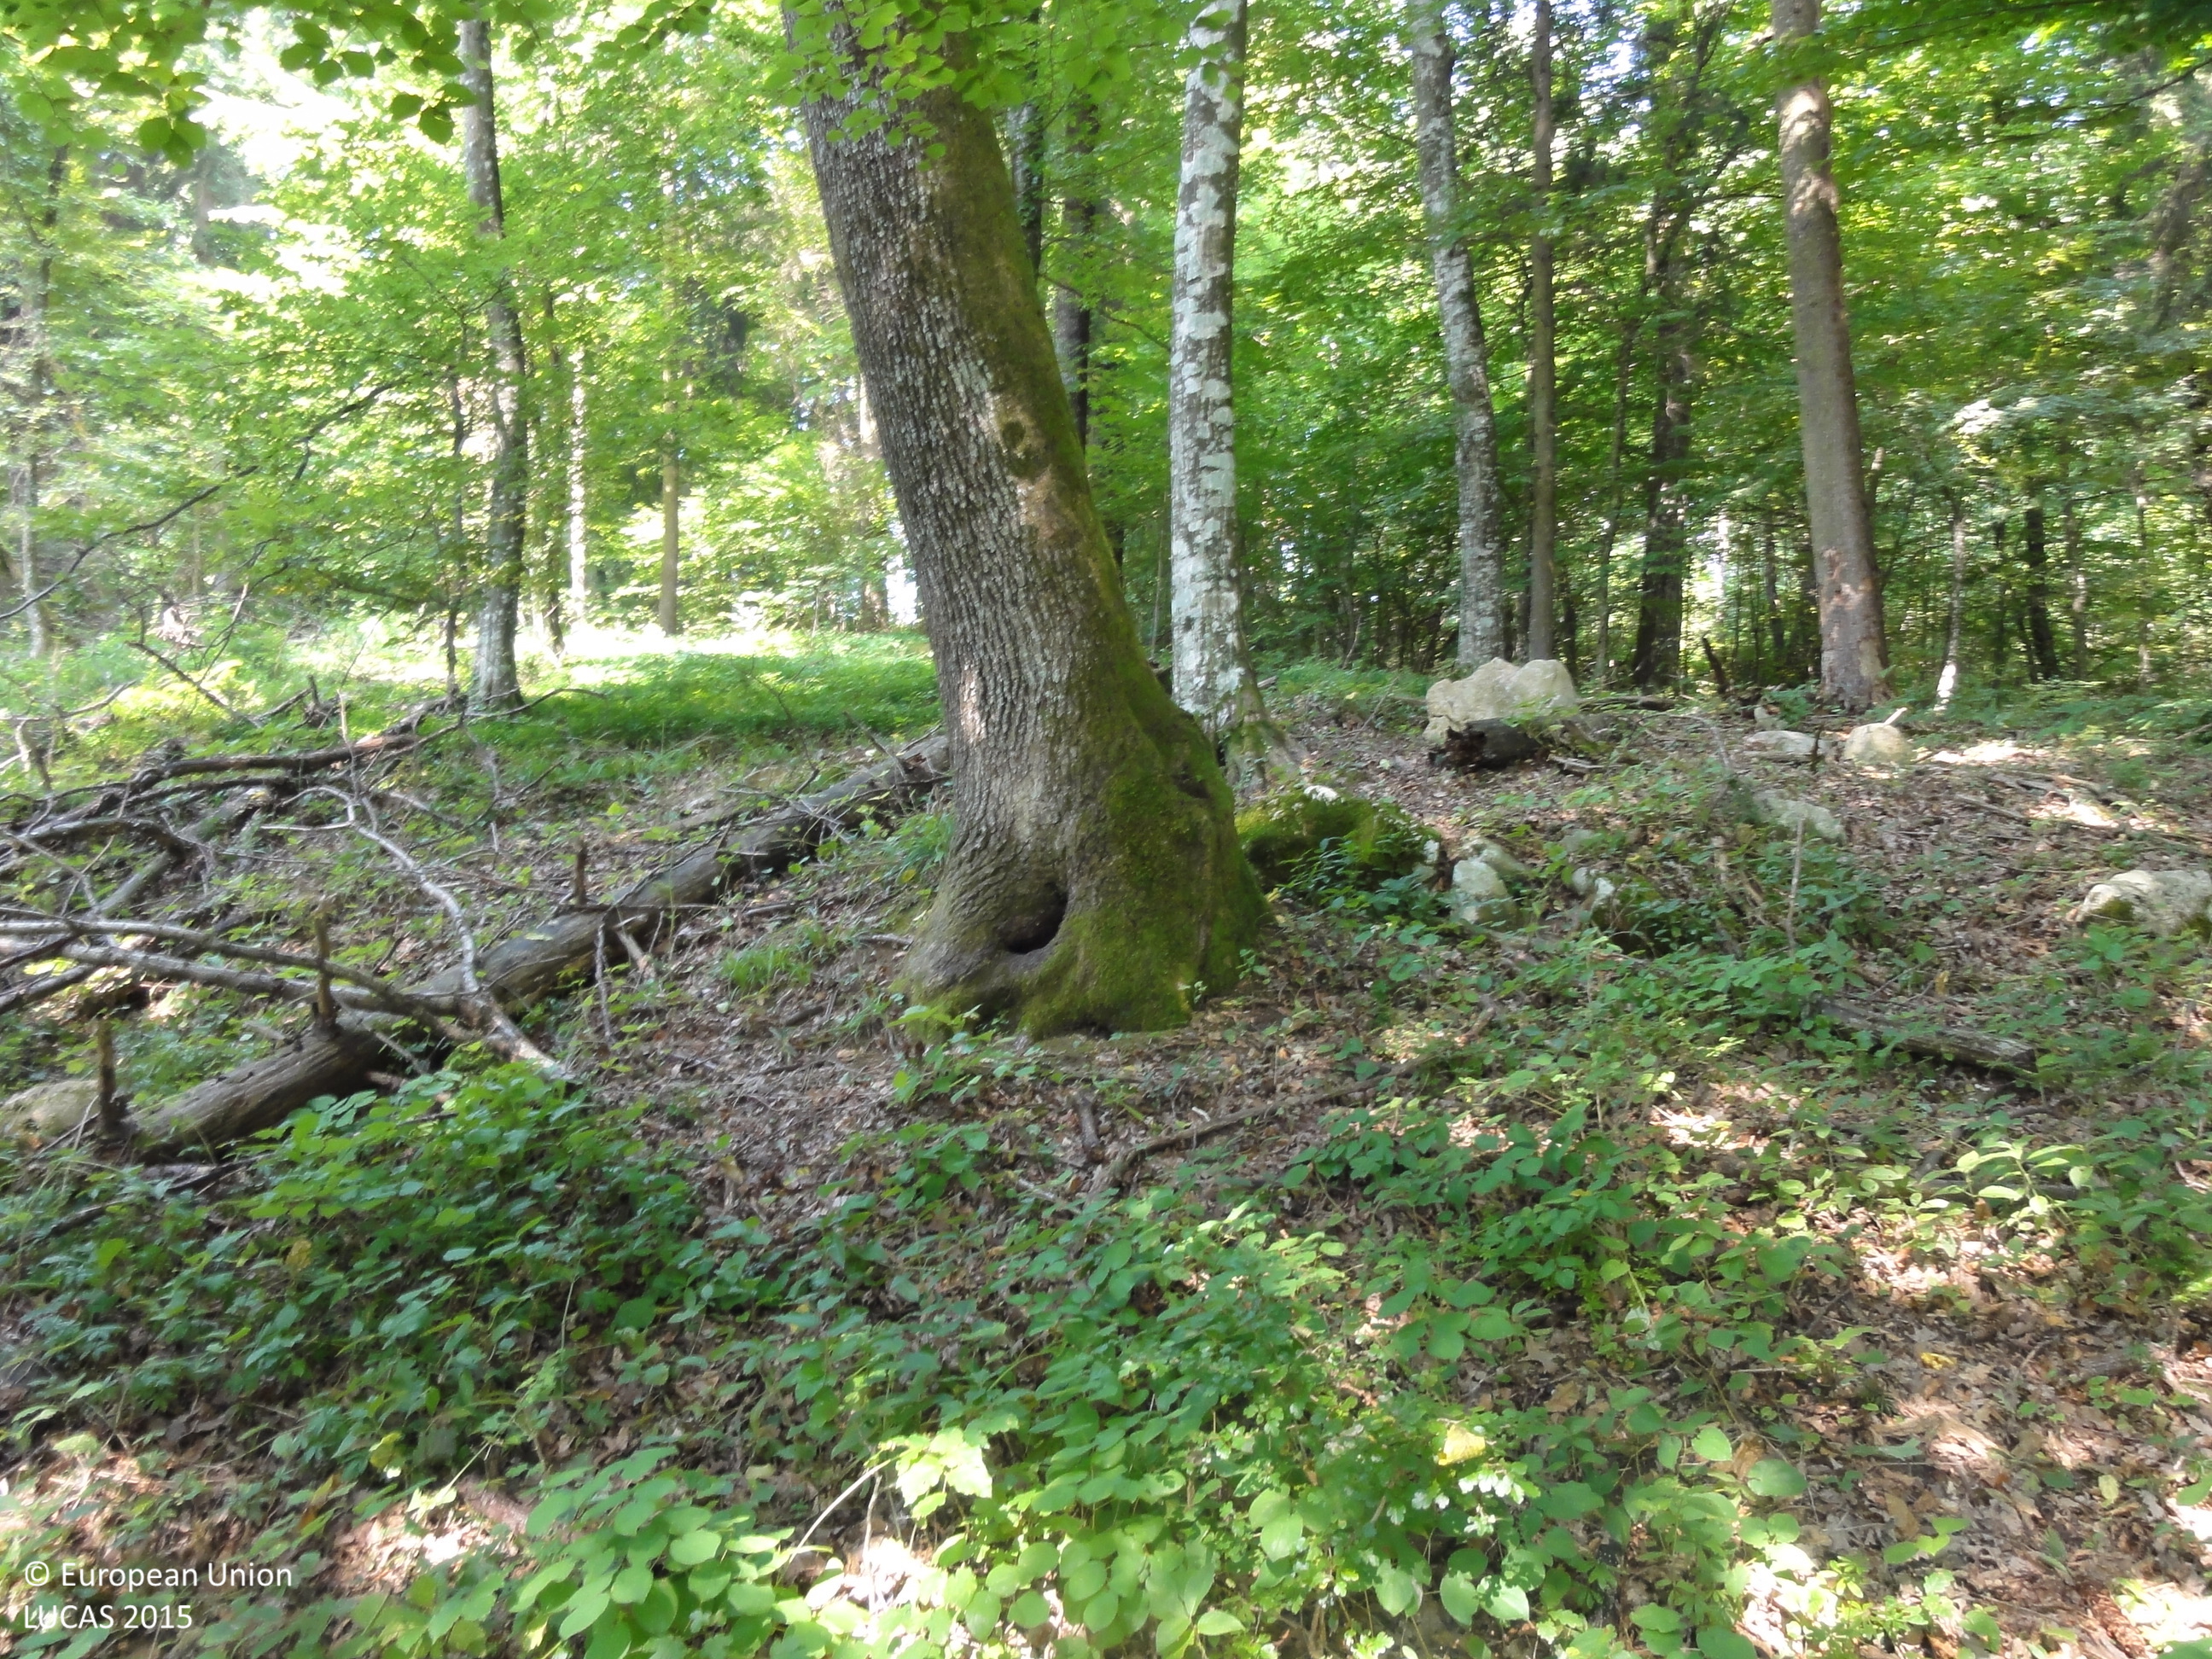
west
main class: Woodland
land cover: Spruce dominated mixed woodland
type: mesophytic deciduous forest
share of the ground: > 75 %
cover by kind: broadleaved forest trees 70 %, coniferous forest trees 30 %
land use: Forestry
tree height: > 5 m
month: August
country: SI
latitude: 45.8451
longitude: 15.2117
